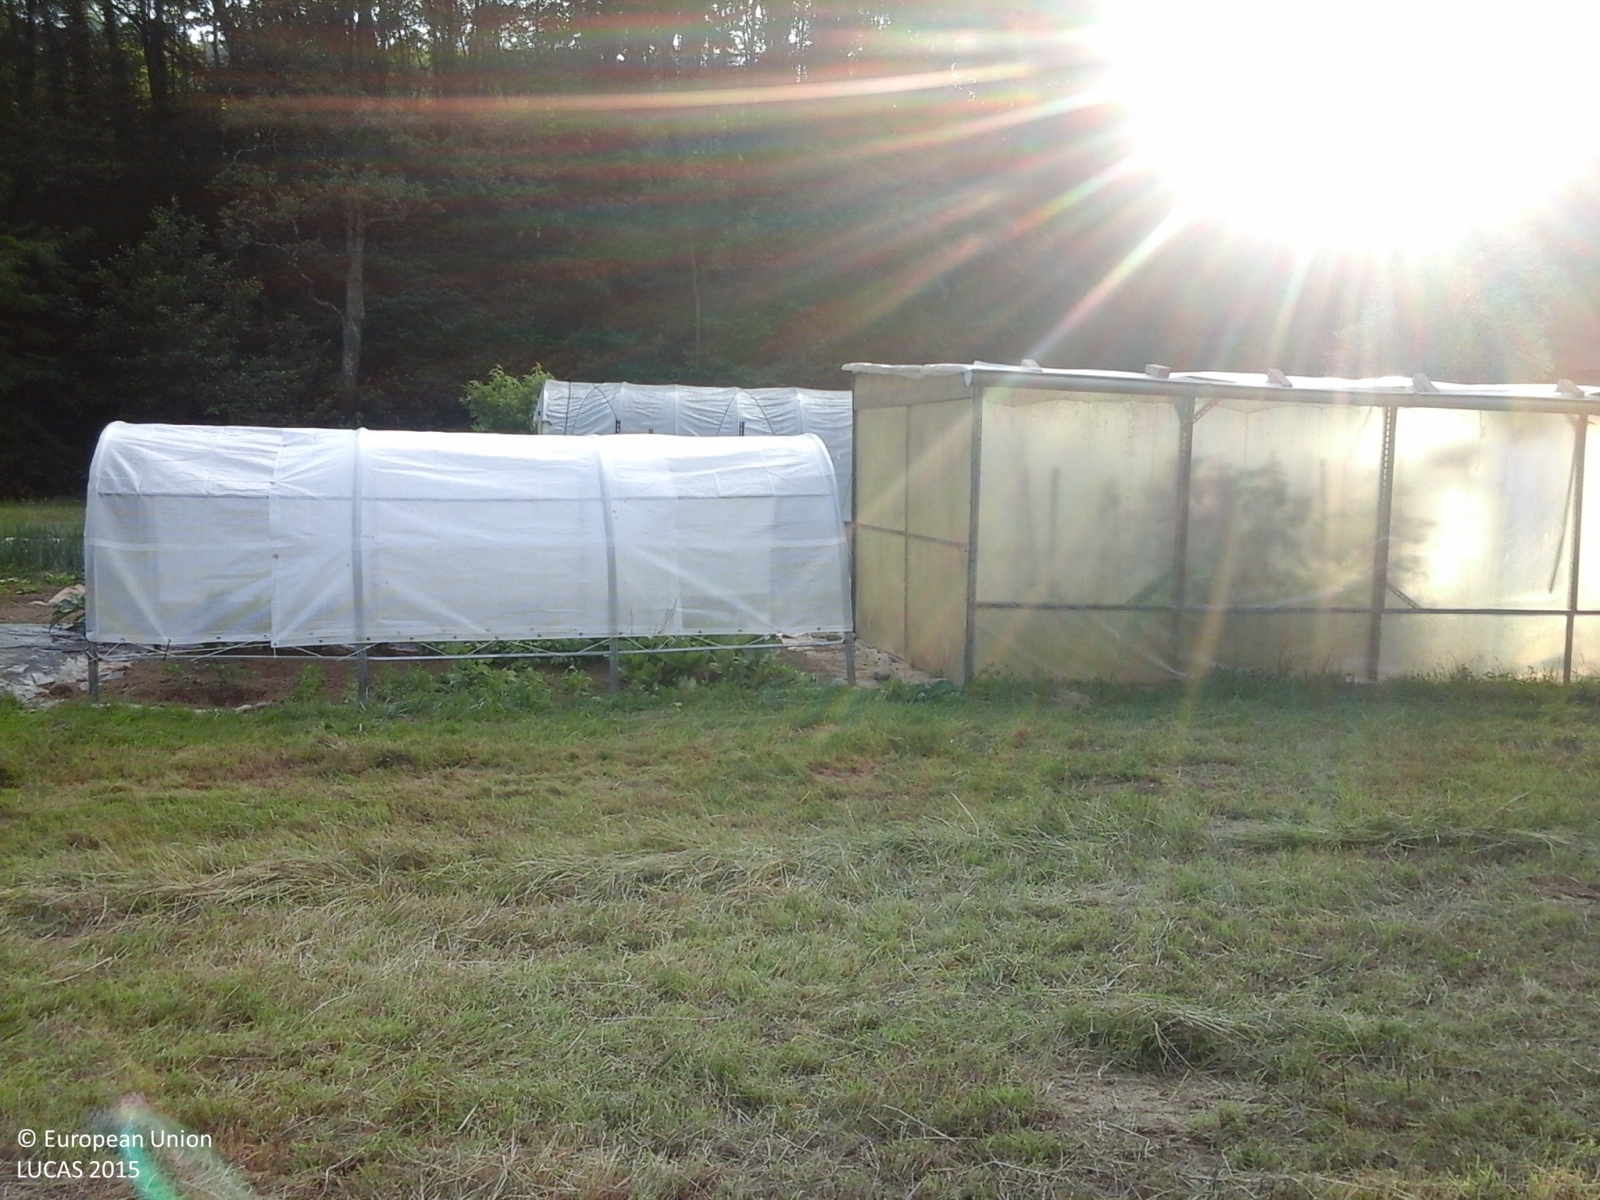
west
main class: Grassland
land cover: Grassland with sparse tree/shrub cover
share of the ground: > 75 %
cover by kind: herbaceous plants 90 %, broadleaved forest trees 5 %, shrubs 5 %
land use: Agriculture (excluding fallow land and kitchen gardens)
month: June
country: IT
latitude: 45.4858
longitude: 8.0200
